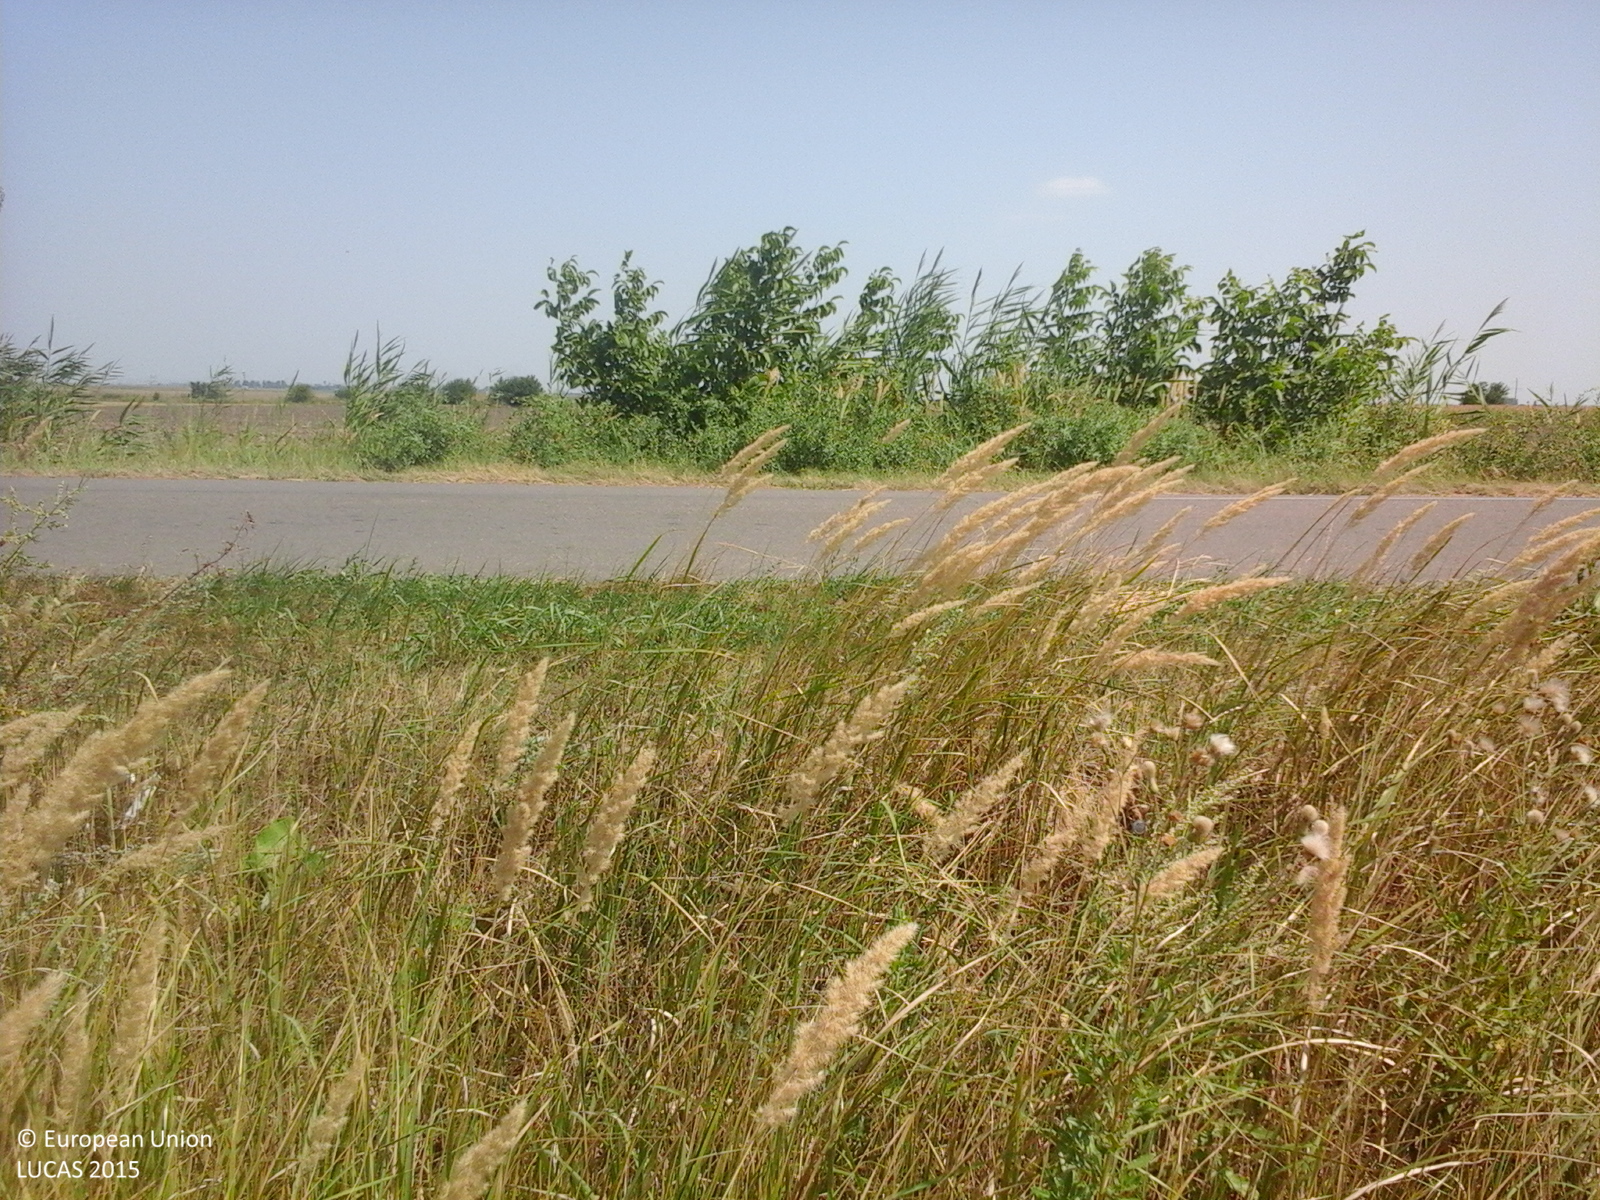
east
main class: Cropland
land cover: Maize
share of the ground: > 75 %
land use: Agriculture (excluding fallow land and kitchen gardens)
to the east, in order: Maize
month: August
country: RO
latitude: 45.2992
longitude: 27.8234
